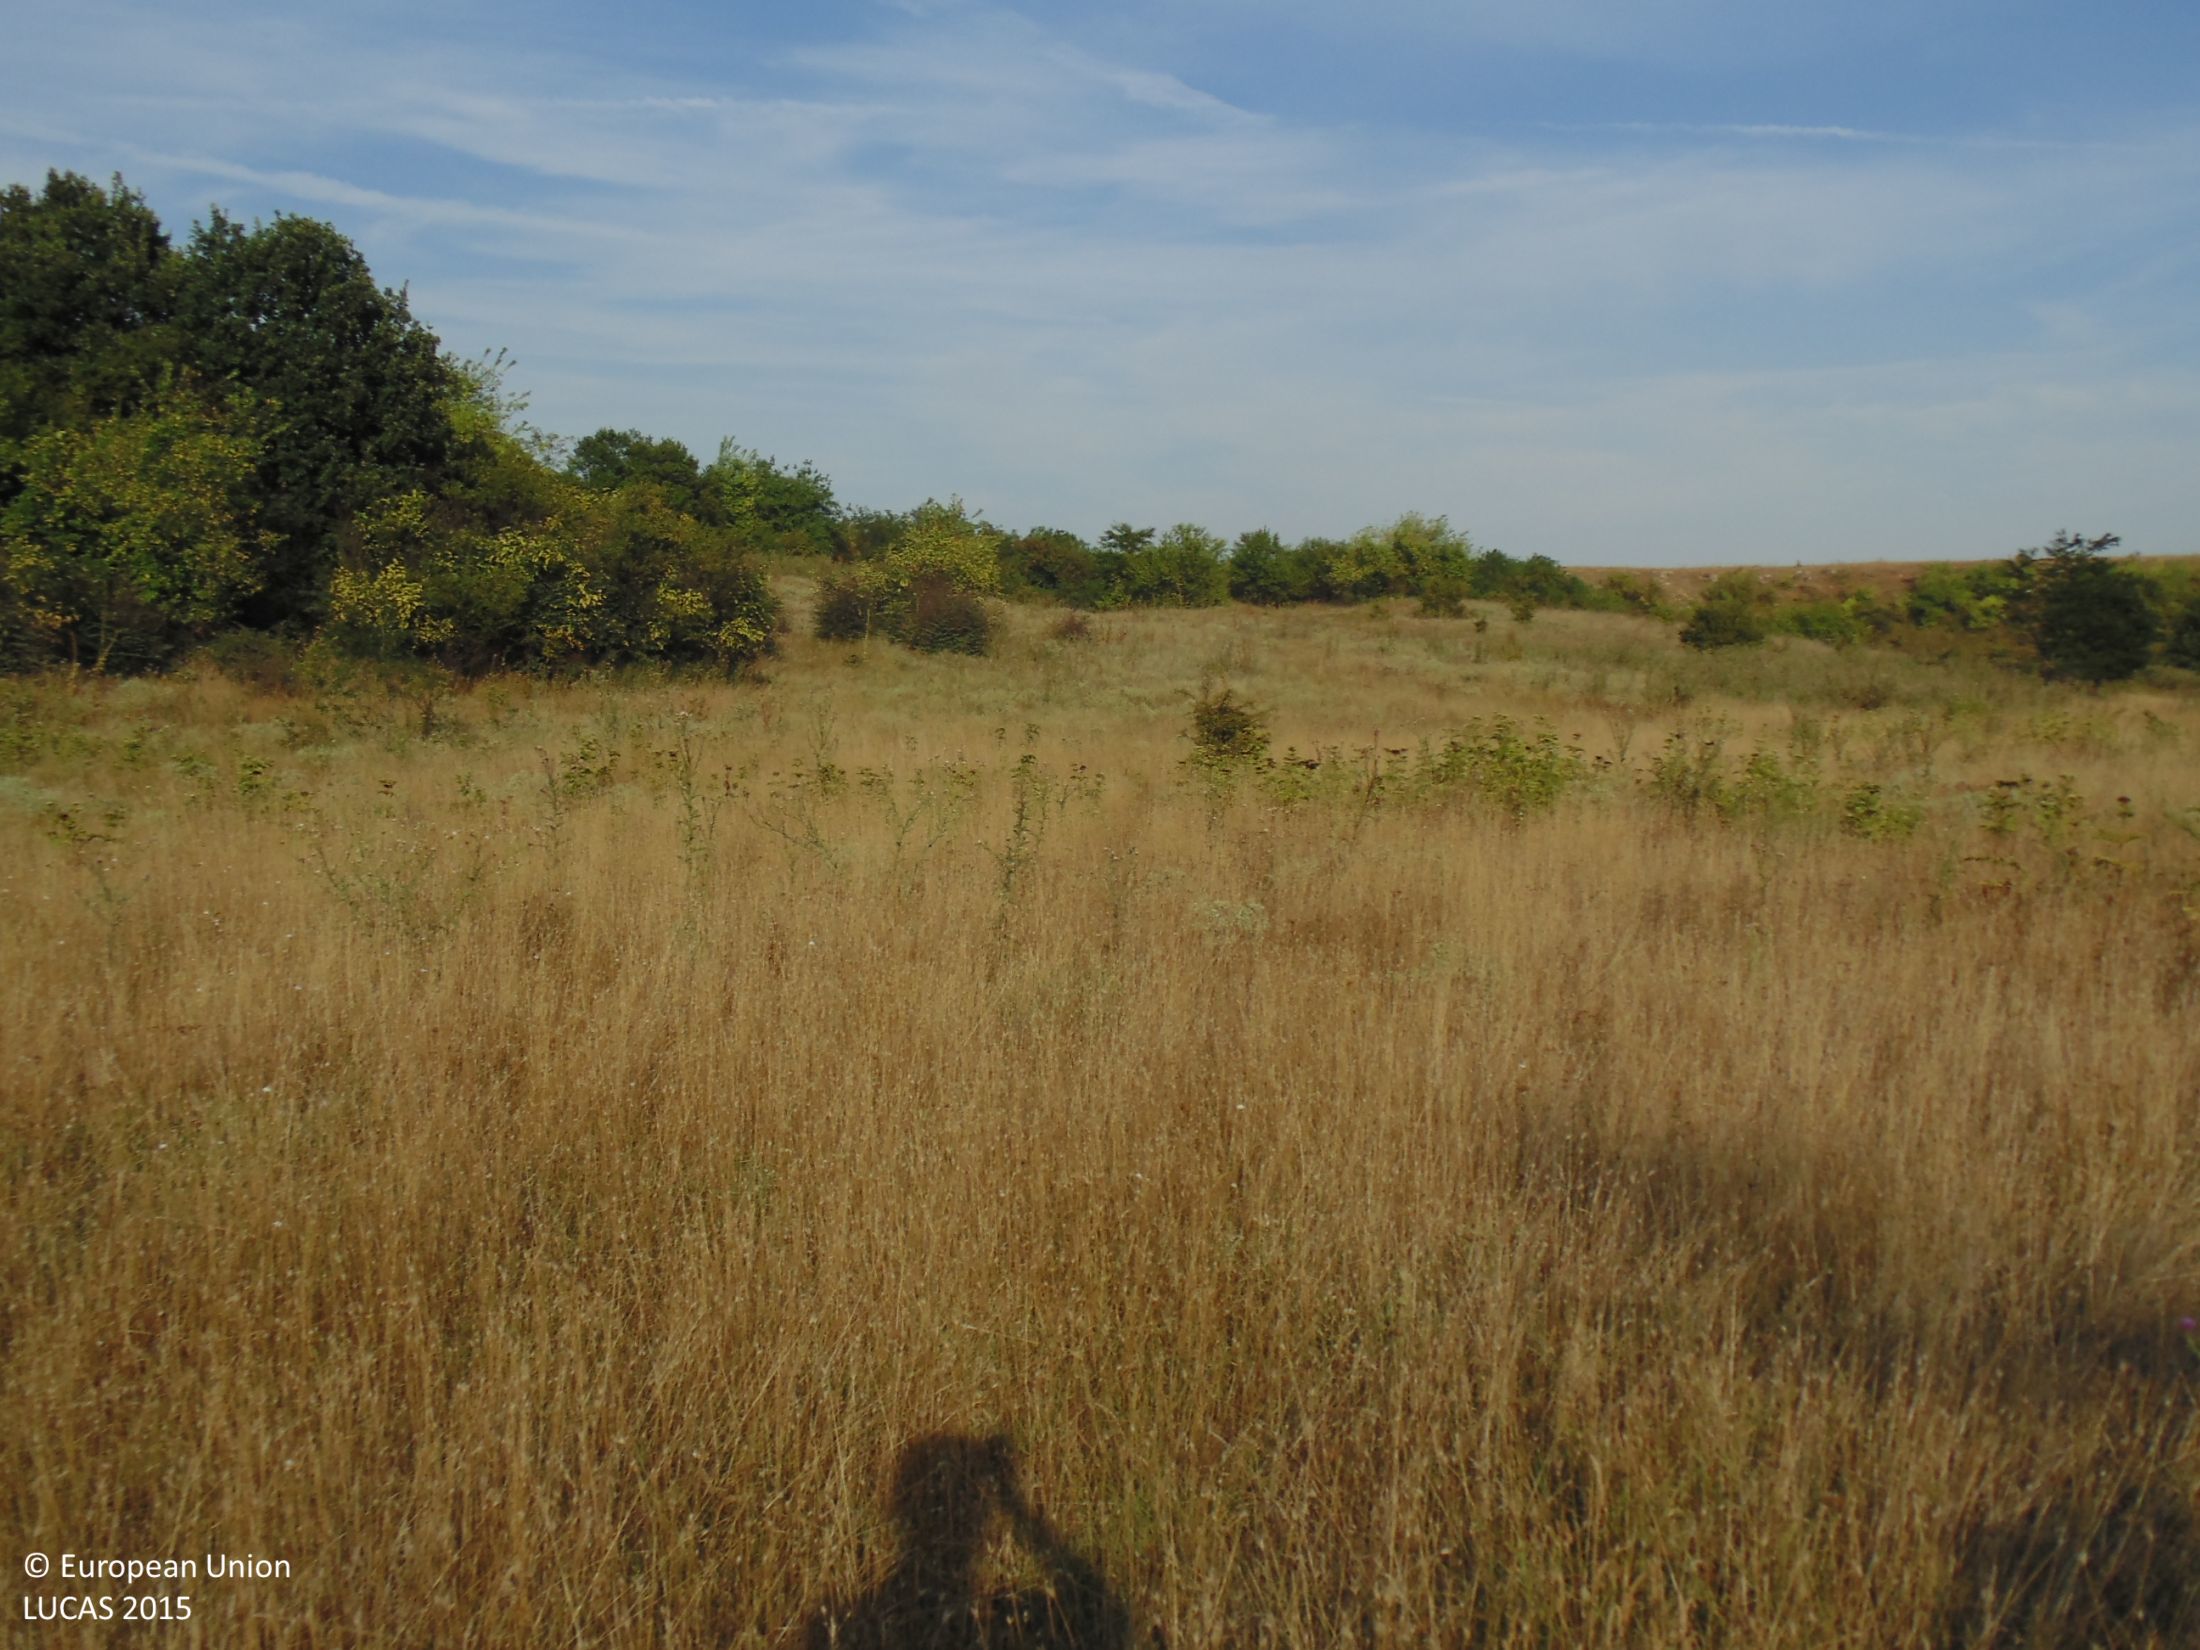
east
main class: Grassland
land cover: Grassland with sparse tree/shrub cover
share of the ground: > 75 %
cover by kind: herbaceous plants 90 %, broadleaved forest trees 5 %, shrubs 5 %
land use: Agriculture (excluding fallow land and kitchen gardens)
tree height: < 5 m
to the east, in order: Grassland with sparse tree/shrub cover; Tracks; Grassland with sparse tree/shrub cover; Tracks; Grass margins; Broadleaved woodland; Grassland with sparse tree/shrub cover
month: August
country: BG
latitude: 43.6658
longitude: 28.3003
